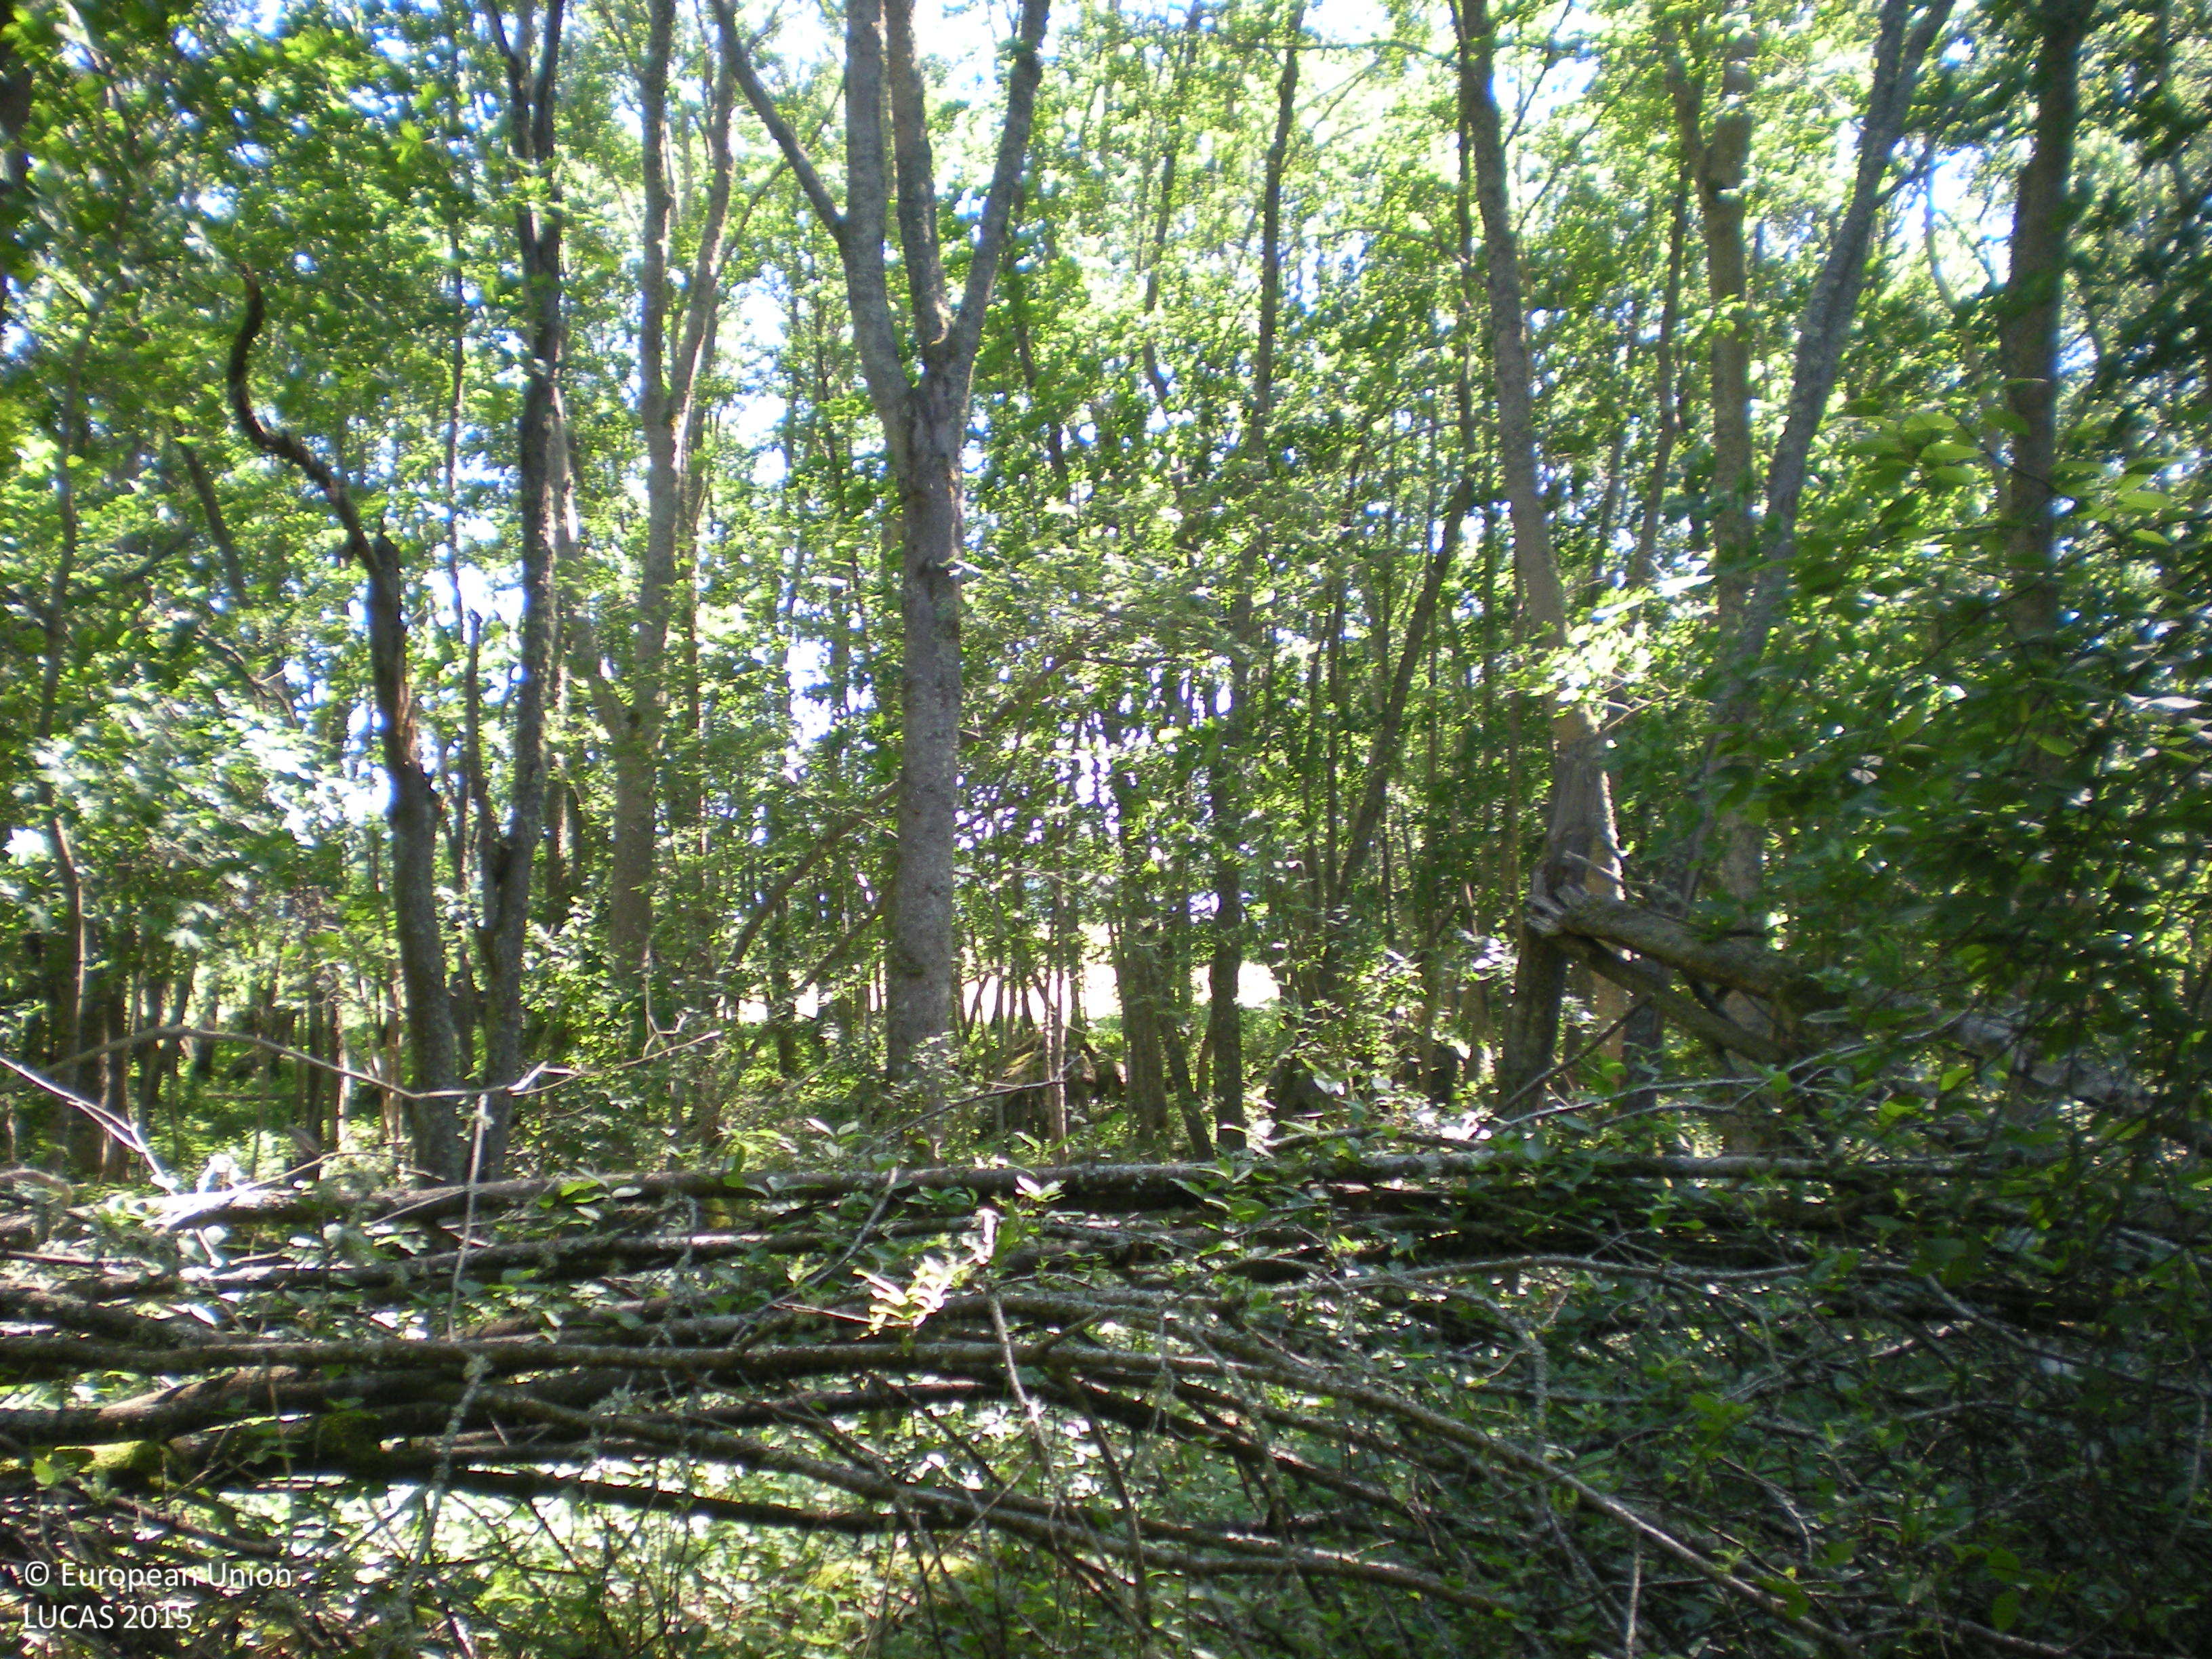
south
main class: Woodland
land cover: Broadleaved woodland
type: boreal forest
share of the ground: > 75 %
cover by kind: broadleaved forest trees 75 %, herbaceous plants 10 %, coniferous forest trees 5 %, consolidated bare surface 5 %
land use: Agriculture (excluding fallow land and kitchen gardens)
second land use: Forestry
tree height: > 5 m
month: July
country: SE
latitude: 60.5115
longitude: 17.7317
